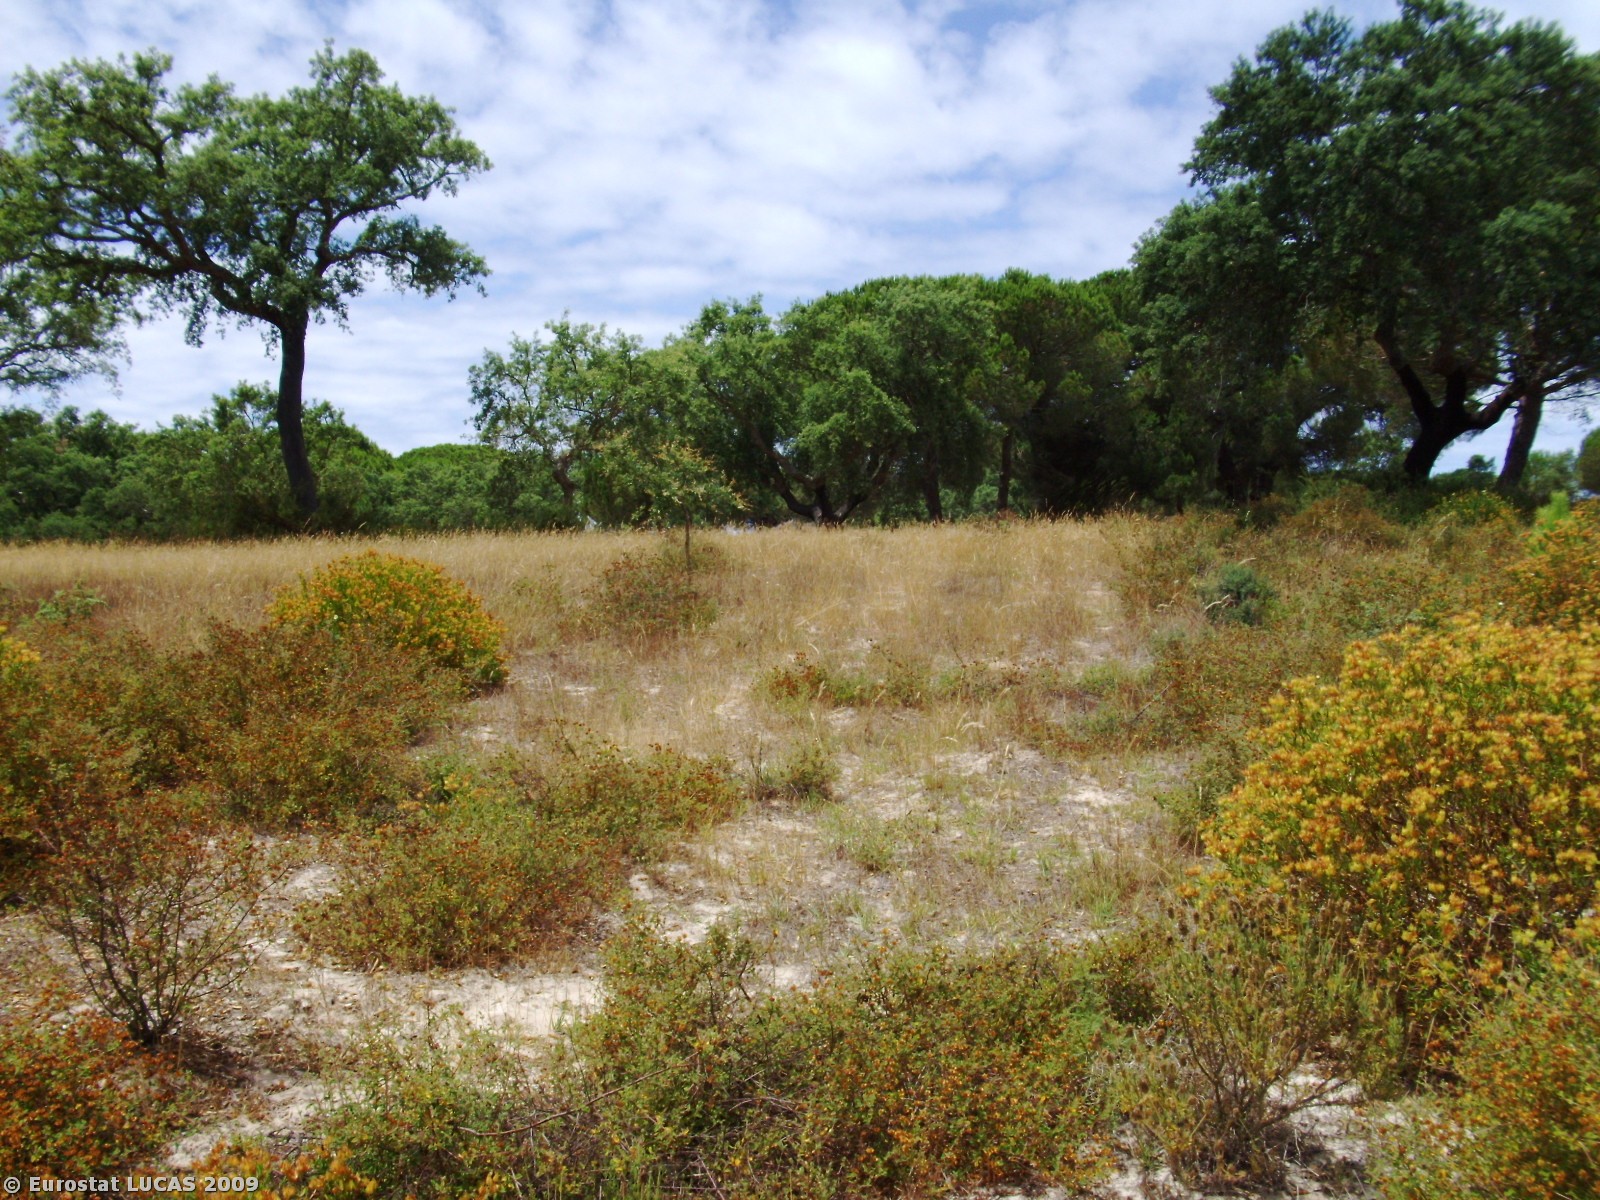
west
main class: Woodland
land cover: Broadleaved woodland
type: broadleaved evergreen forest
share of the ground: 25 - 50 %
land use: Forestry
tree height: > 5 m
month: June
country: PT
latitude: 38.1090
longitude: -8.7442
